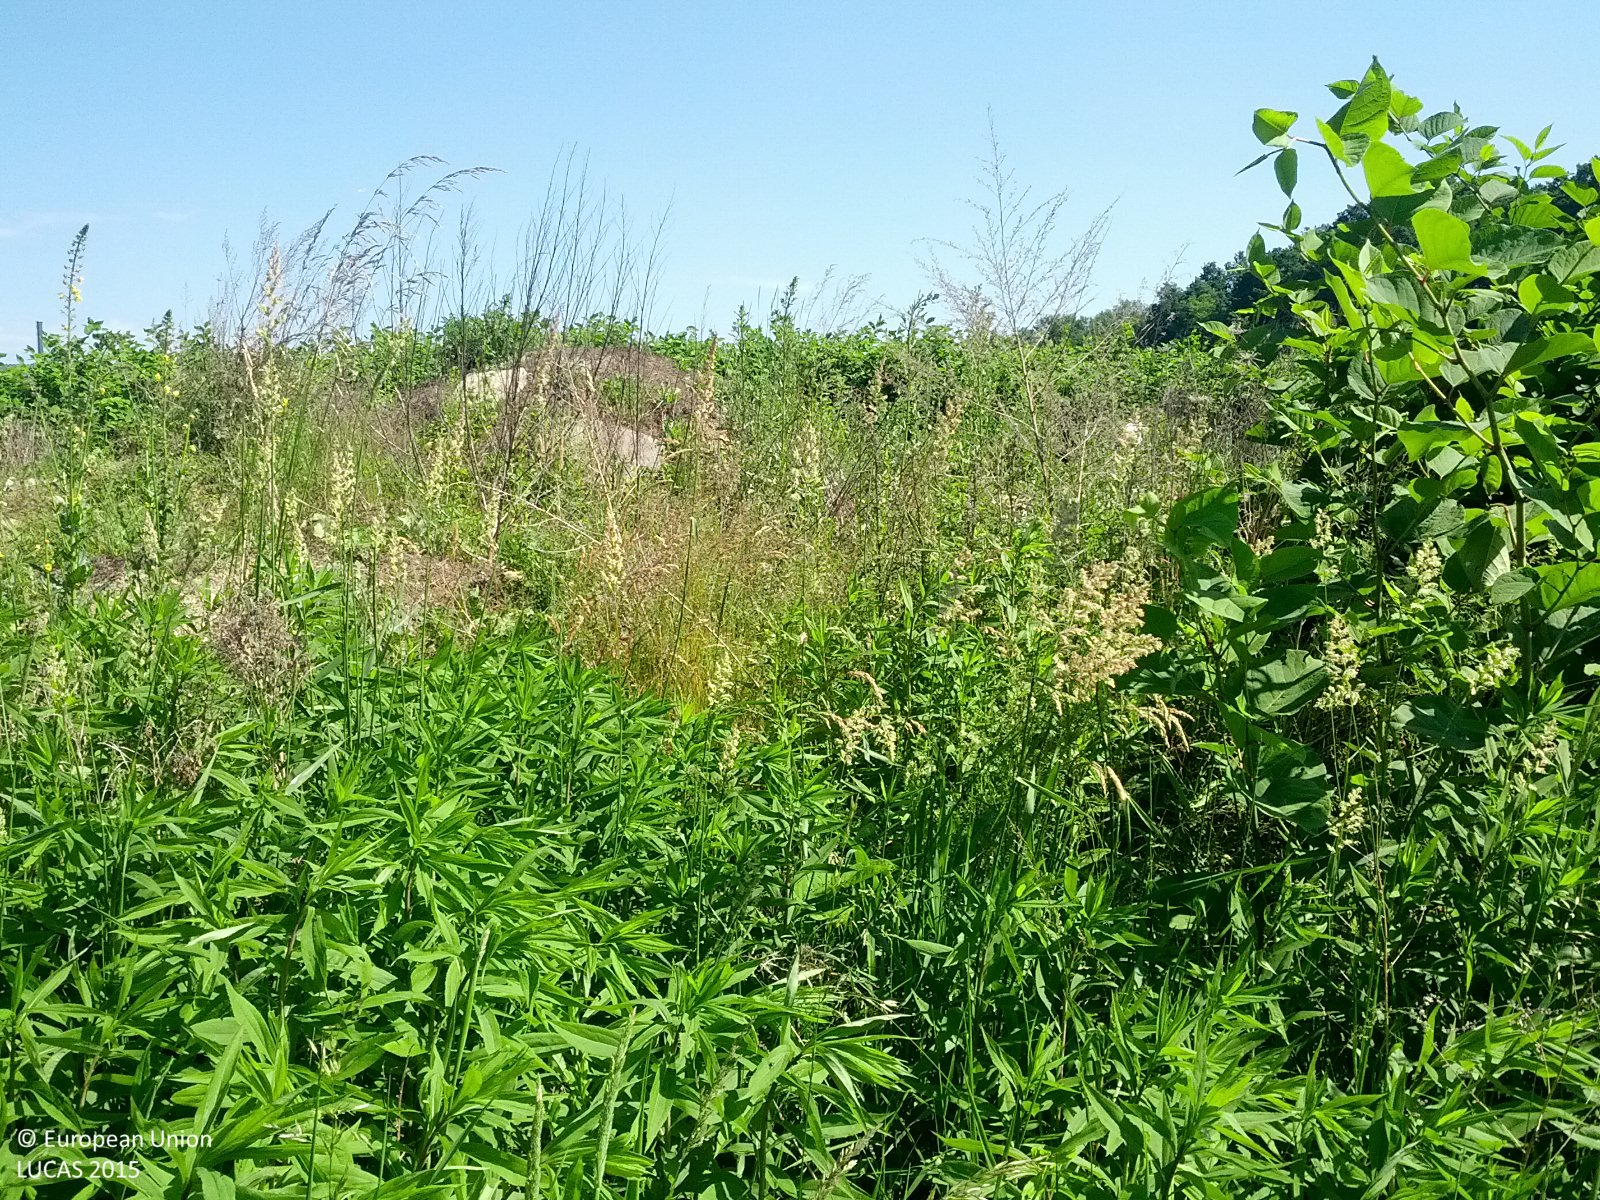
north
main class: Grassland
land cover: Grassland without tree/shrub cover
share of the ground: > 75 %
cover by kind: herbaceous plants 90 %, shrubs 5 %, unconsolidated bare surface 5 %
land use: Abandoned areas
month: June
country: AT
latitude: 47.1667
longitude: 16.1626
